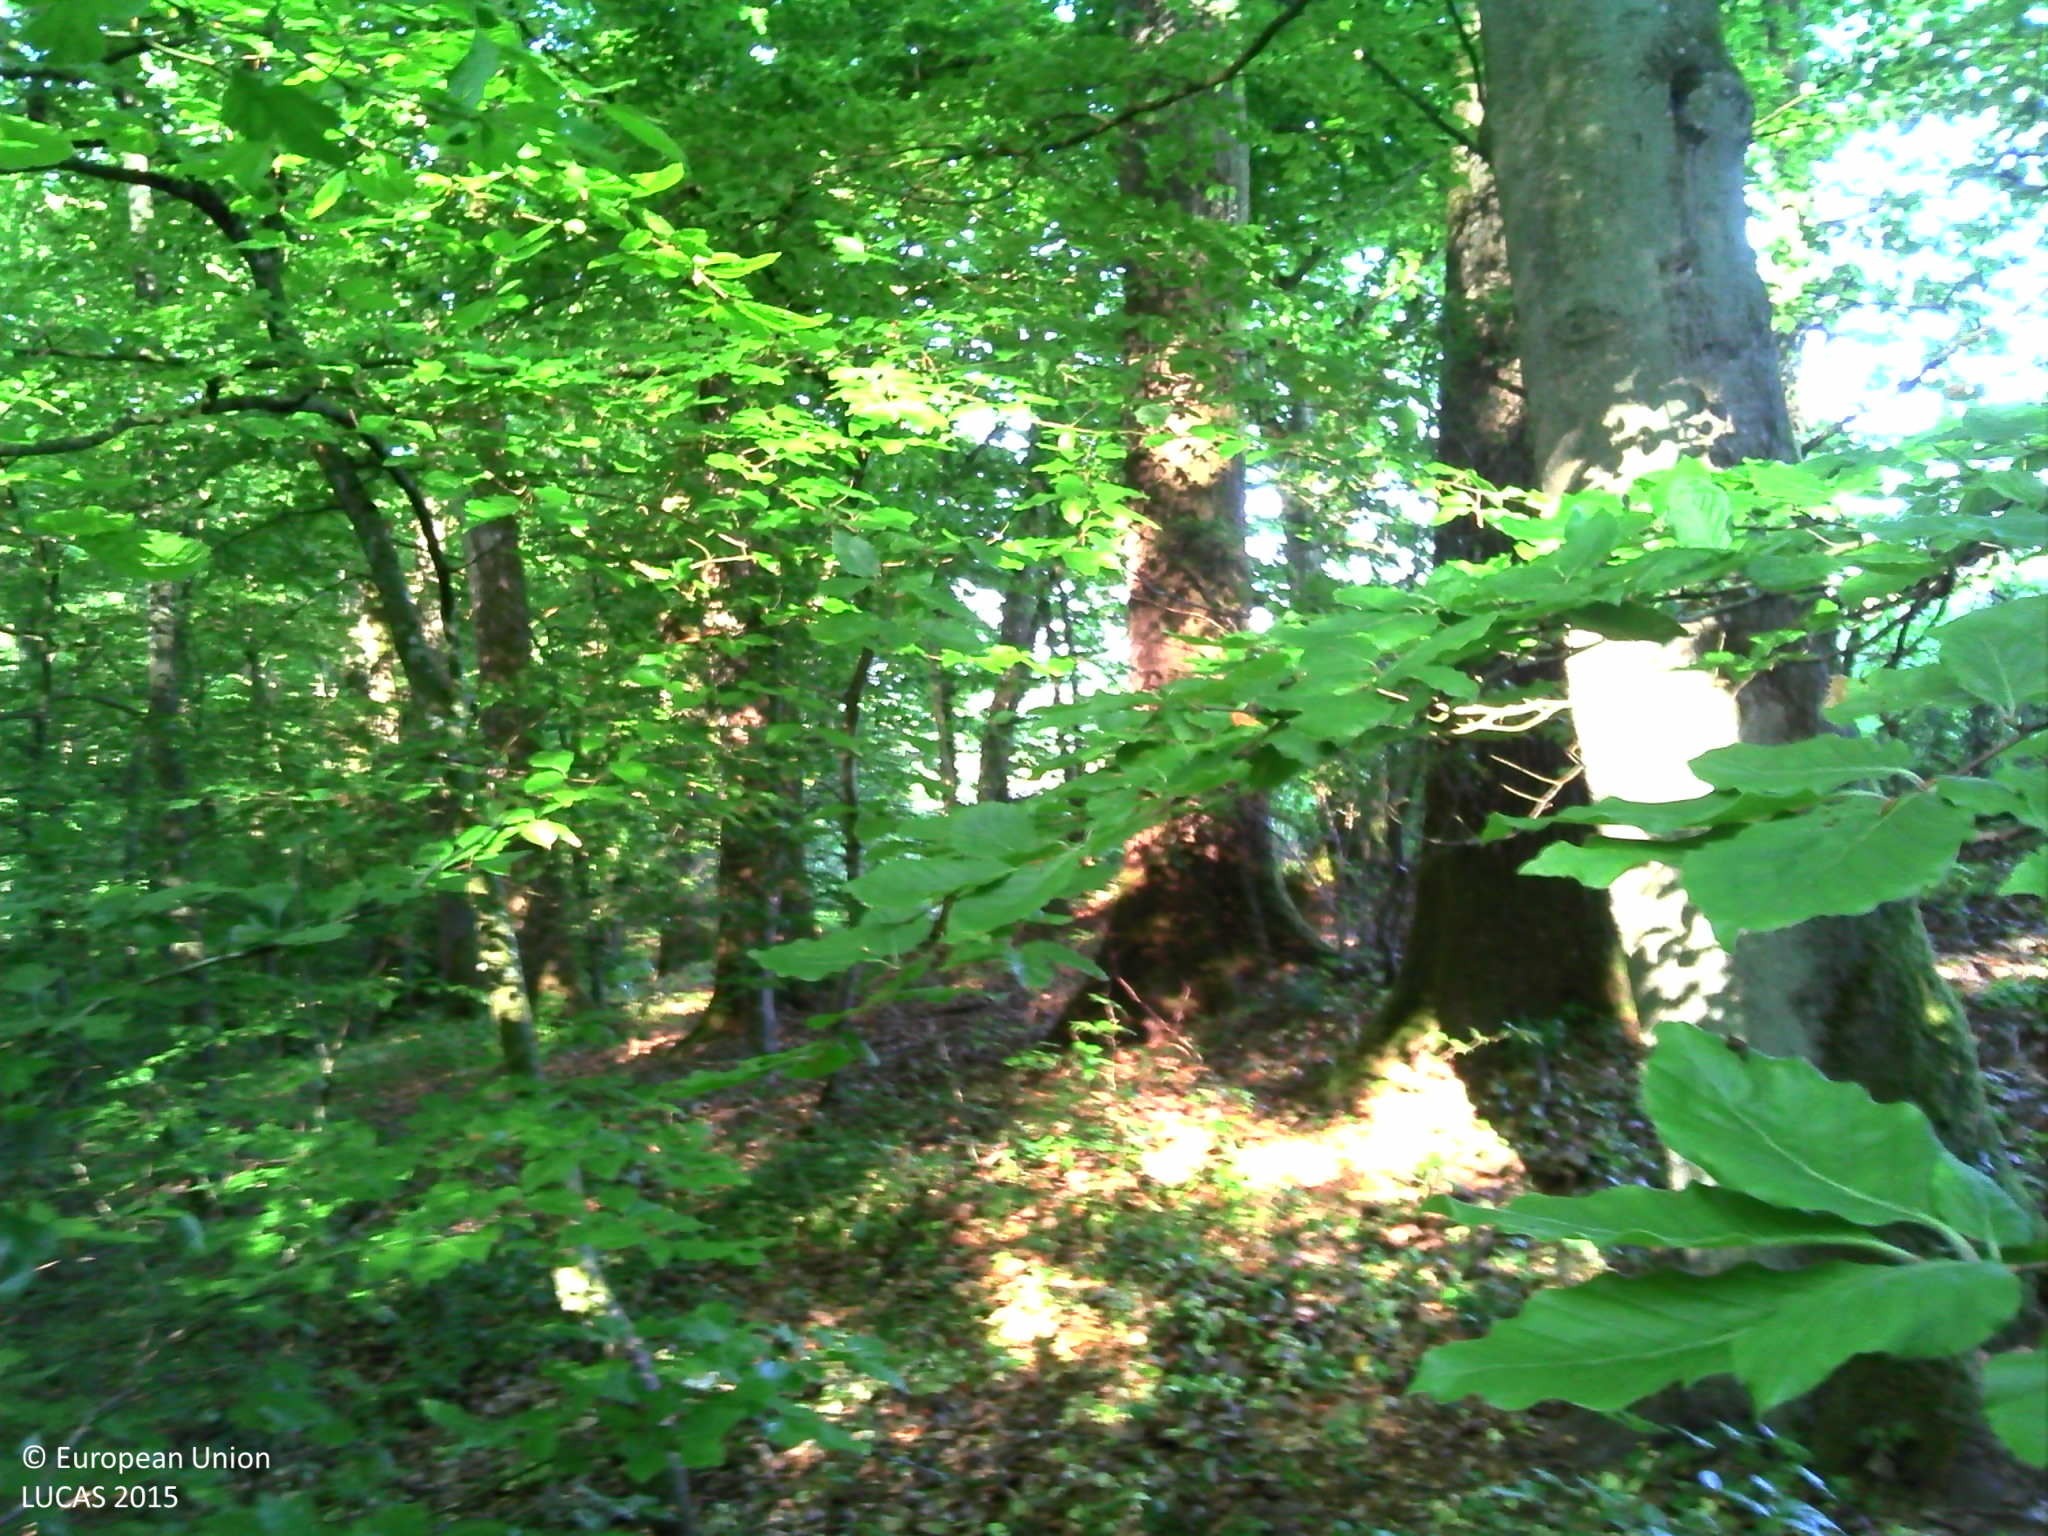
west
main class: Woodland
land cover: Broadleaved woodland
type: mesophytic deciduous forest
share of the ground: > 75 %
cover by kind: broadleaved forest trees 90 %, herbaceous plants 5 %, lichens and mosses 5 %
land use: Forestry
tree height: > 5 m
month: May
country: LU
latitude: 49.6409
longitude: 6.3854
